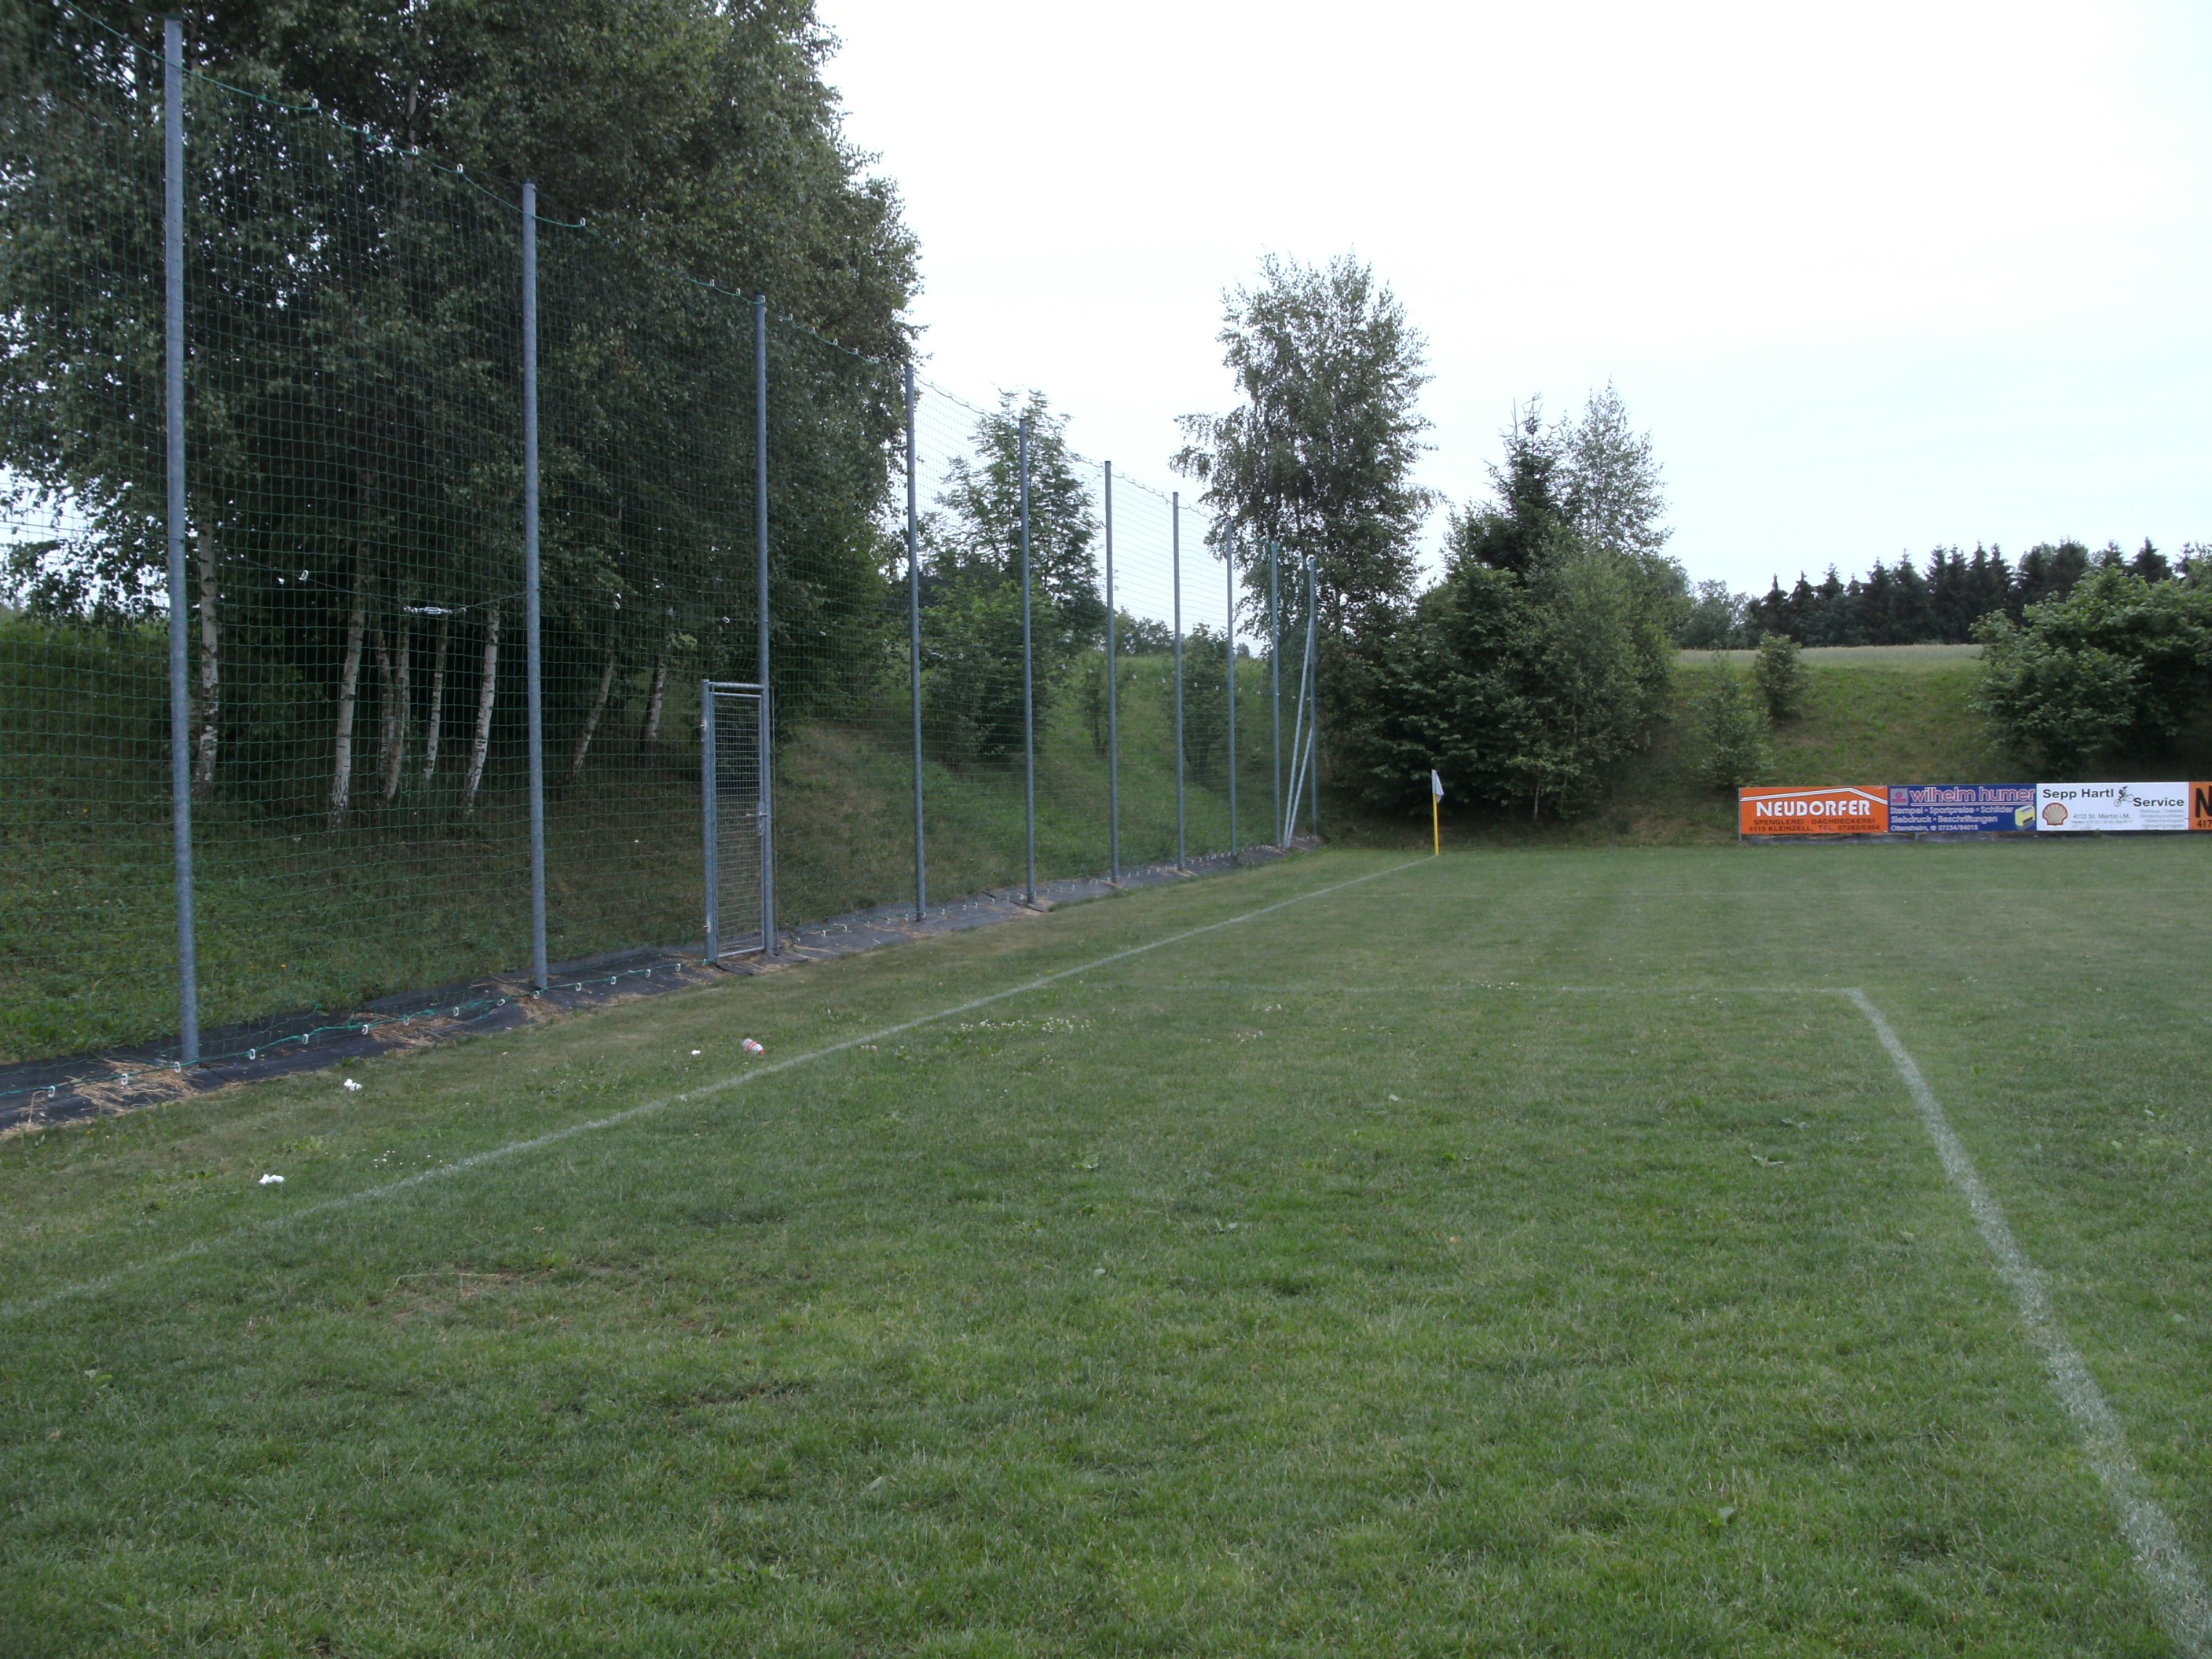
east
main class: Grassland
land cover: Grassland without tree/shrub cover
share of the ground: > 75 %
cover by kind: herbaceous plants 100 %
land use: Sport
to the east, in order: Grassland without tree/shrub cover; Fences; Broadleaved woodland; Tracks; Temporary grasslands; Grassland without tree/shrub cover; Broadleaved woodland
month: June
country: AT
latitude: 48.4348
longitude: 14.1226
